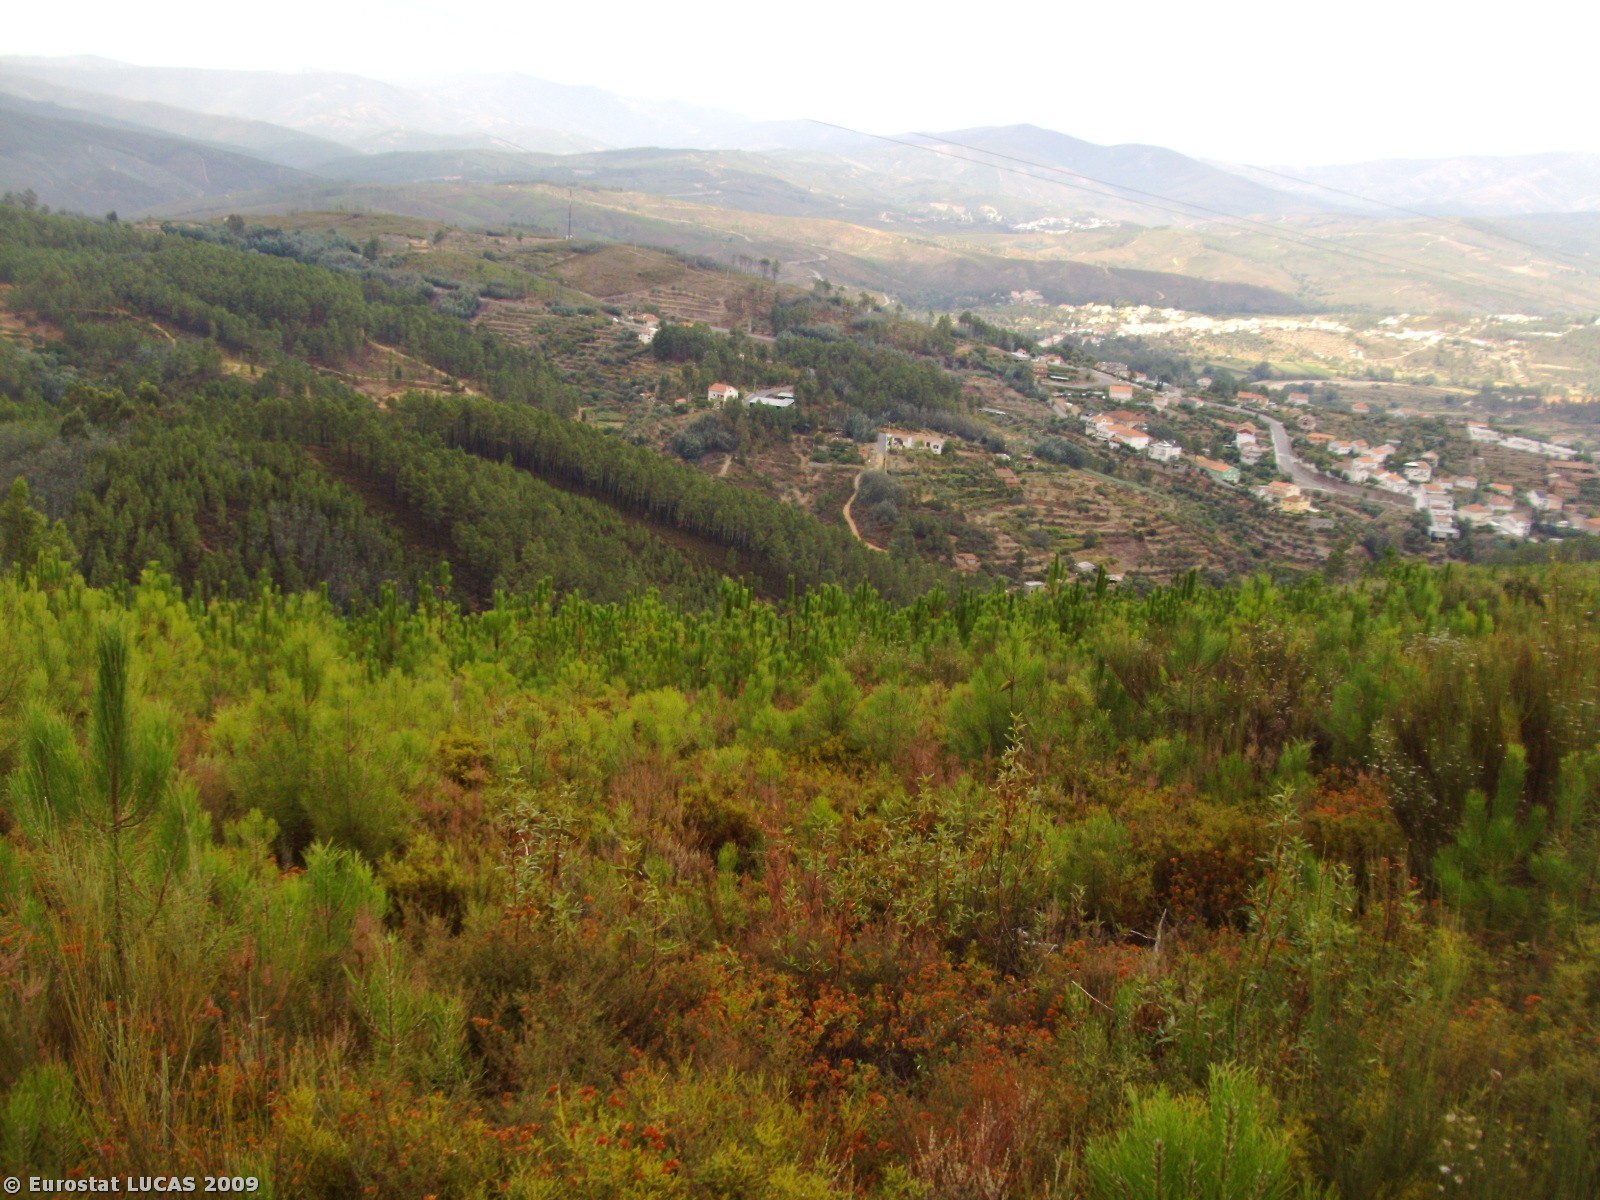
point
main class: Woodland
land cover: Coniferous woodland
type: coniferous forest of the mediterranean region
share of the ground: > 75 %
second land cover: Shrubland with sparse tree cover
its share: 10 - 25 %
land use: Forestry
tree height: > 5 m
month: August
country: PT
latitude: 40.1252
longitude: -7.6758
